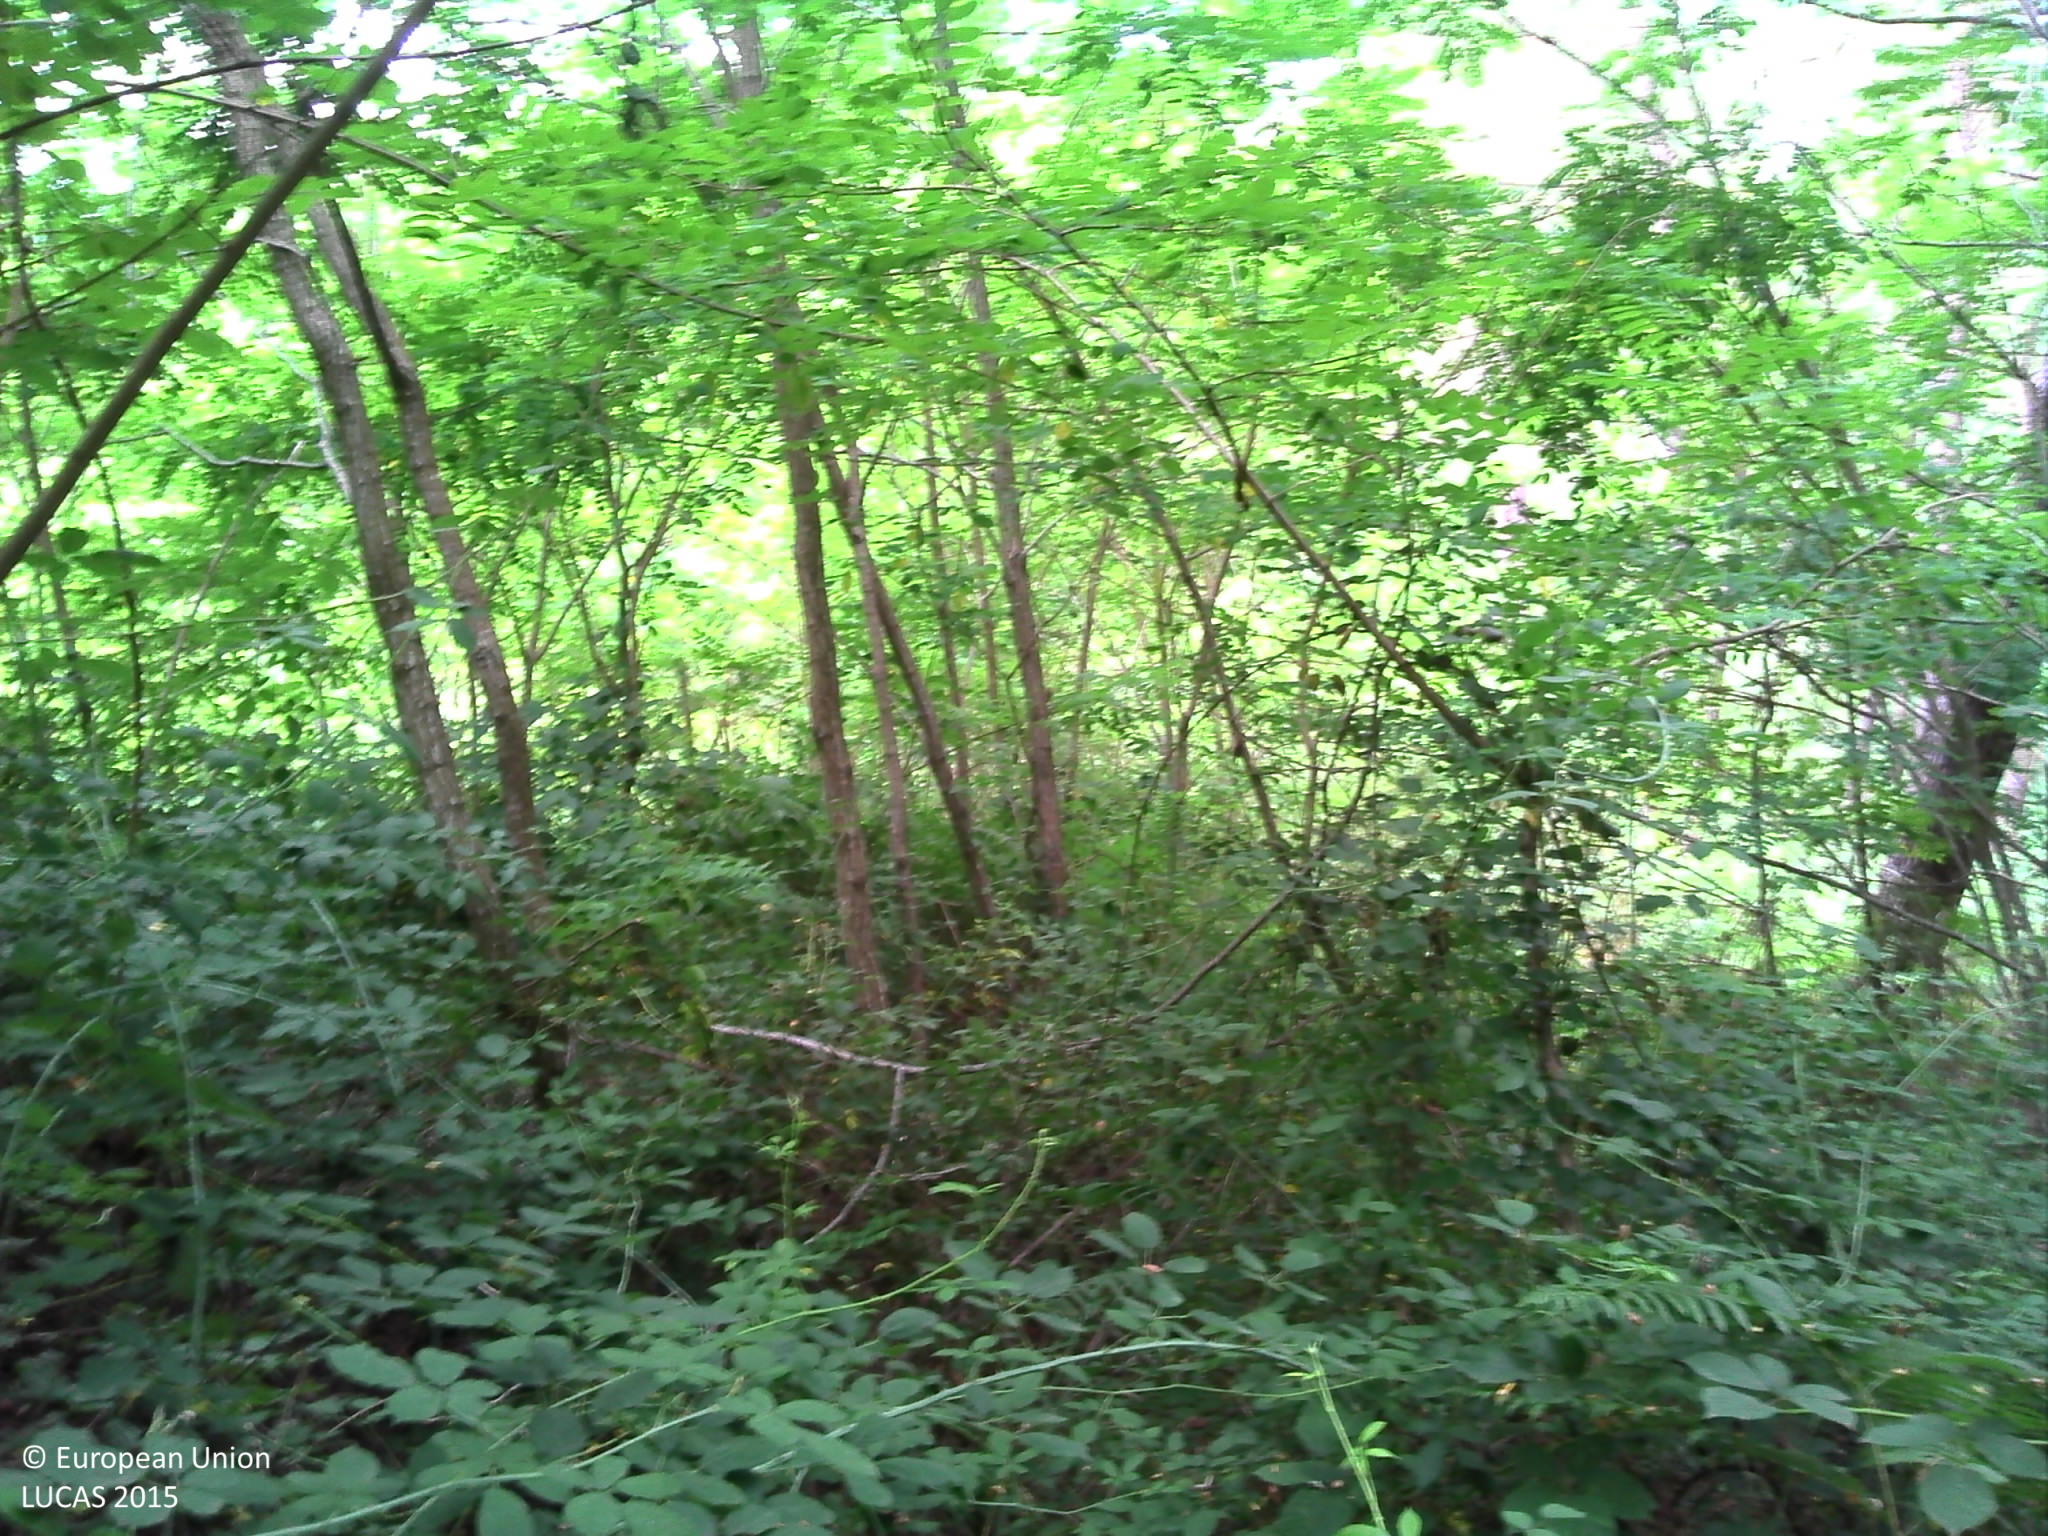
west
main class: Woodland
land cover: Pine dominated mixed woodland
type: coniferous forest of the mediterranean region
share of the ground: > 75 %
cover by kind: coniferous forest trees 30 %, broadleaved forest trees 30 %, shrubs 20 %, herbaceous plants 20 %
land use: Forestry
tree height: > 5 m
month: July
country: FR
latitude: 44.9703
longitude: 0.5439
